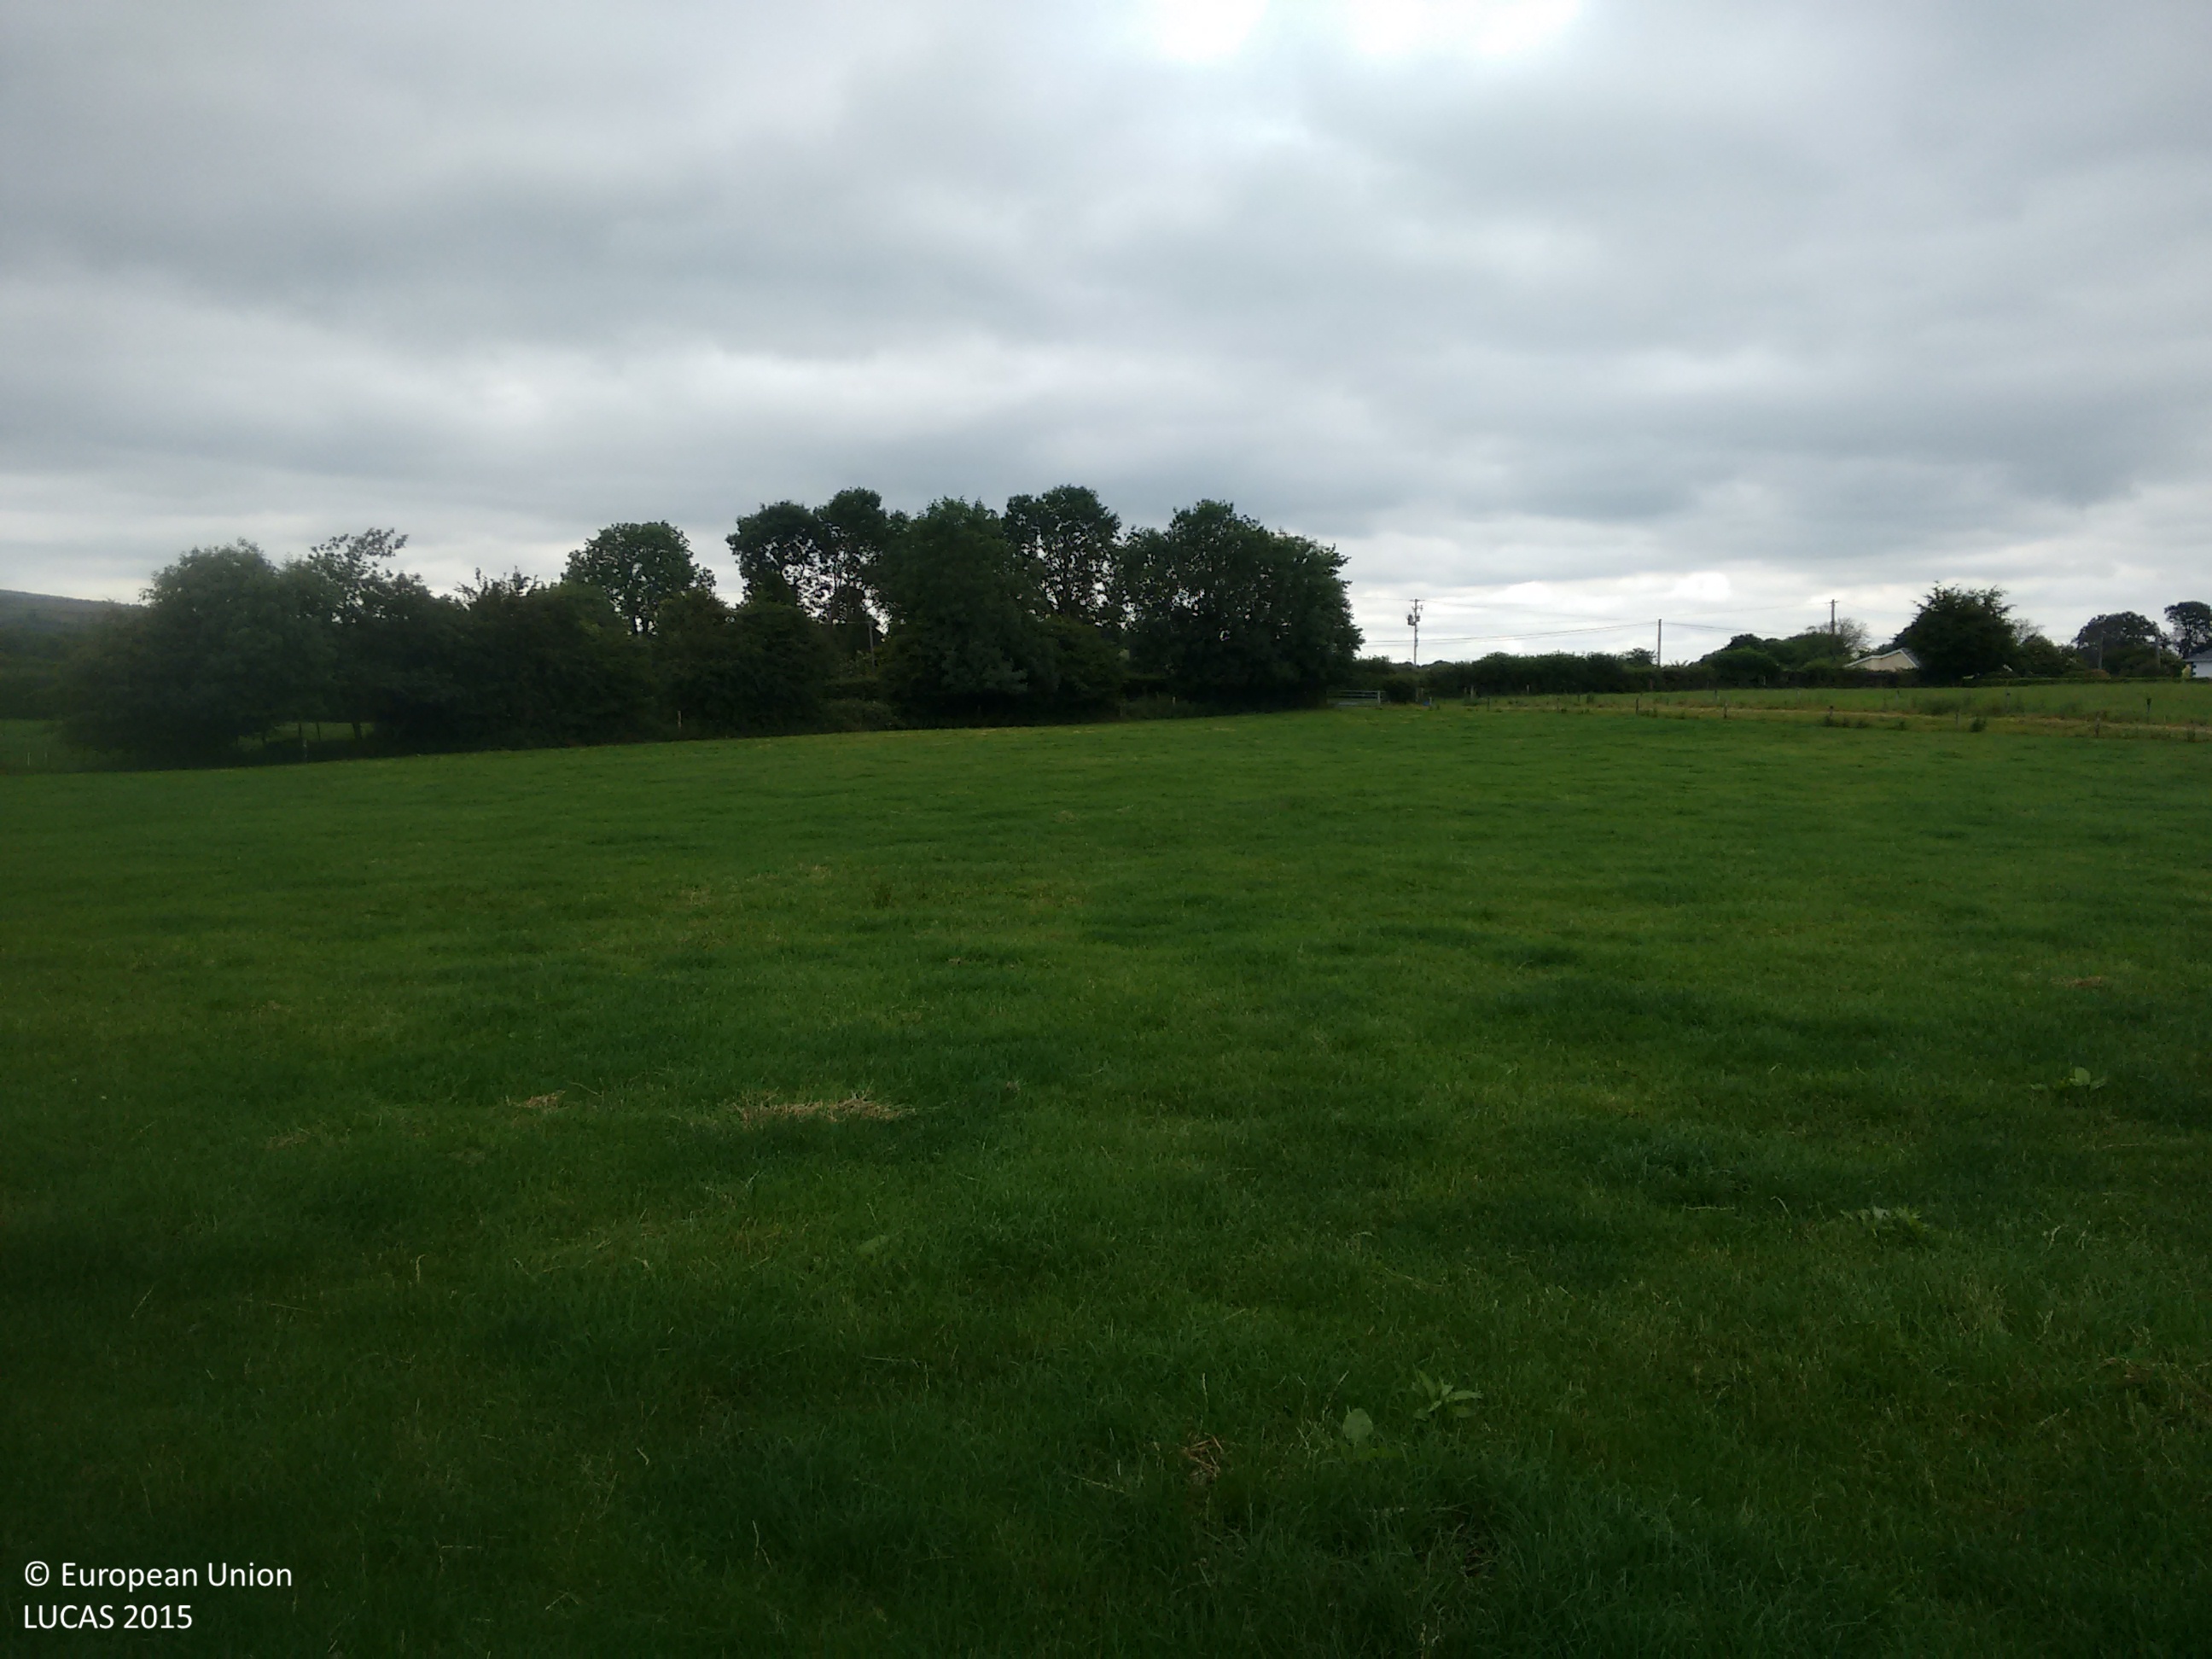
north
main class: Grassland
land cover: Grassland without tree/shrub cover
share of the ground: > 75 %
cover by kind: herbaceous plants 100 %
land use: Agriculture (excluding fallow land and kitchen gardens)
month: July
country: IE
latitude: 52.9260
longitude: -6.7197
